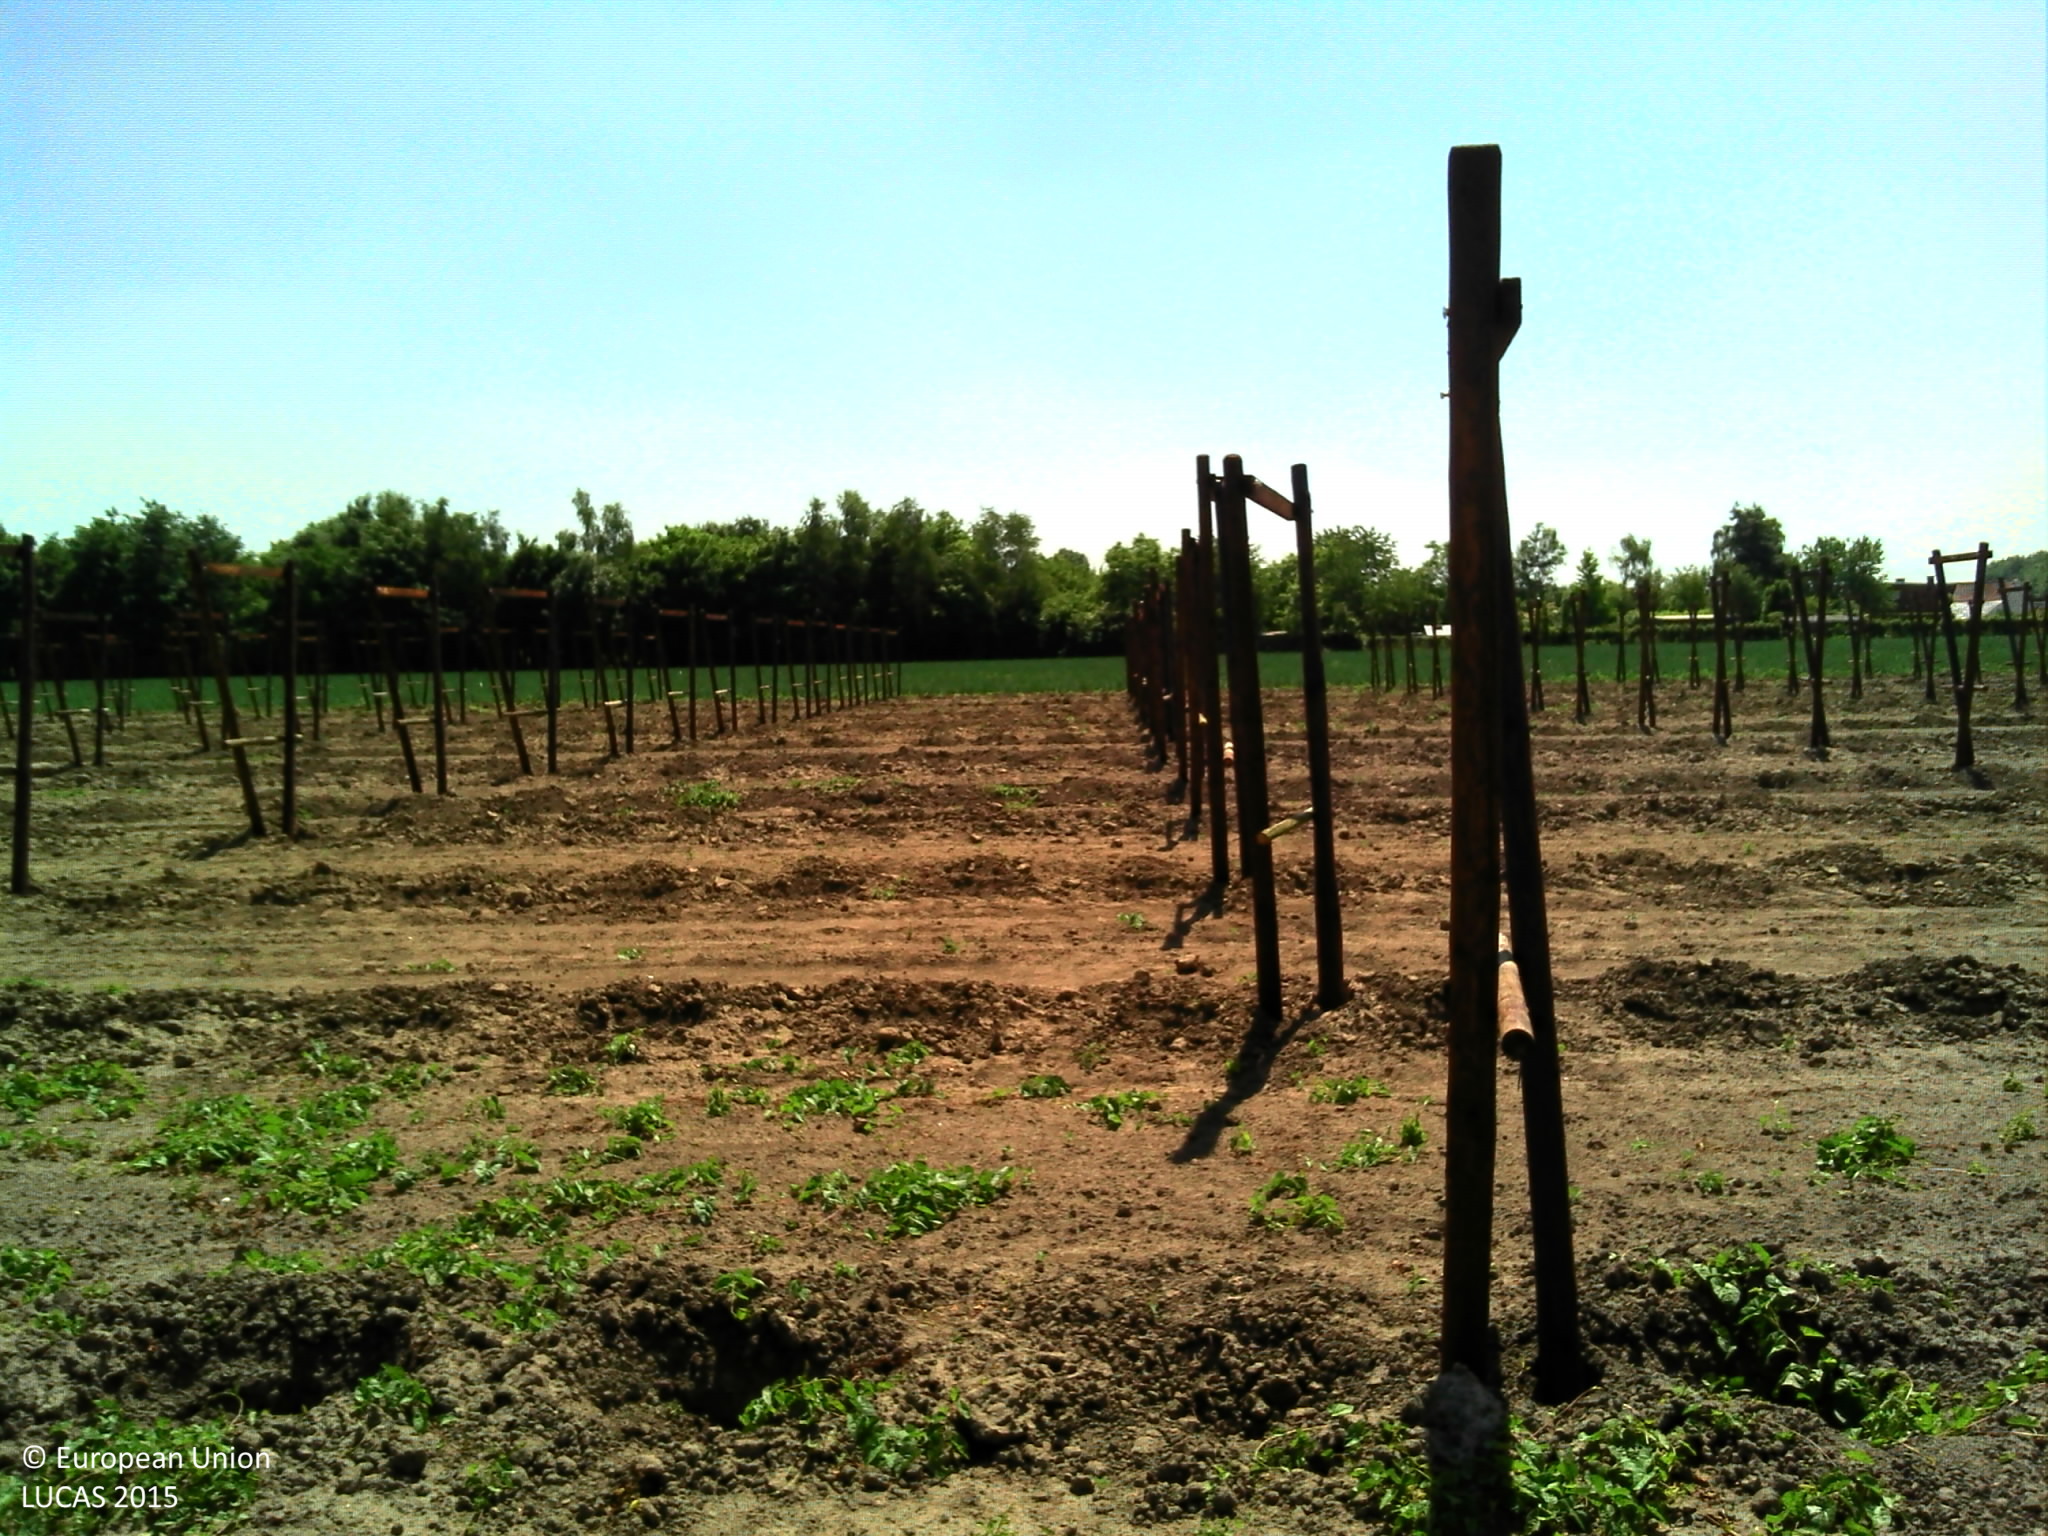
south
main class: Grassland
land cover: Grassland without tree/shrub cover
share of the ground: > 75 %
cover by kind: herbaceous plants 100 %
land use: Agriculture (excluding fallow land and kitchen gardens)
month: June
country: BE
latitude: 51.2398
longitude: 3.7624
